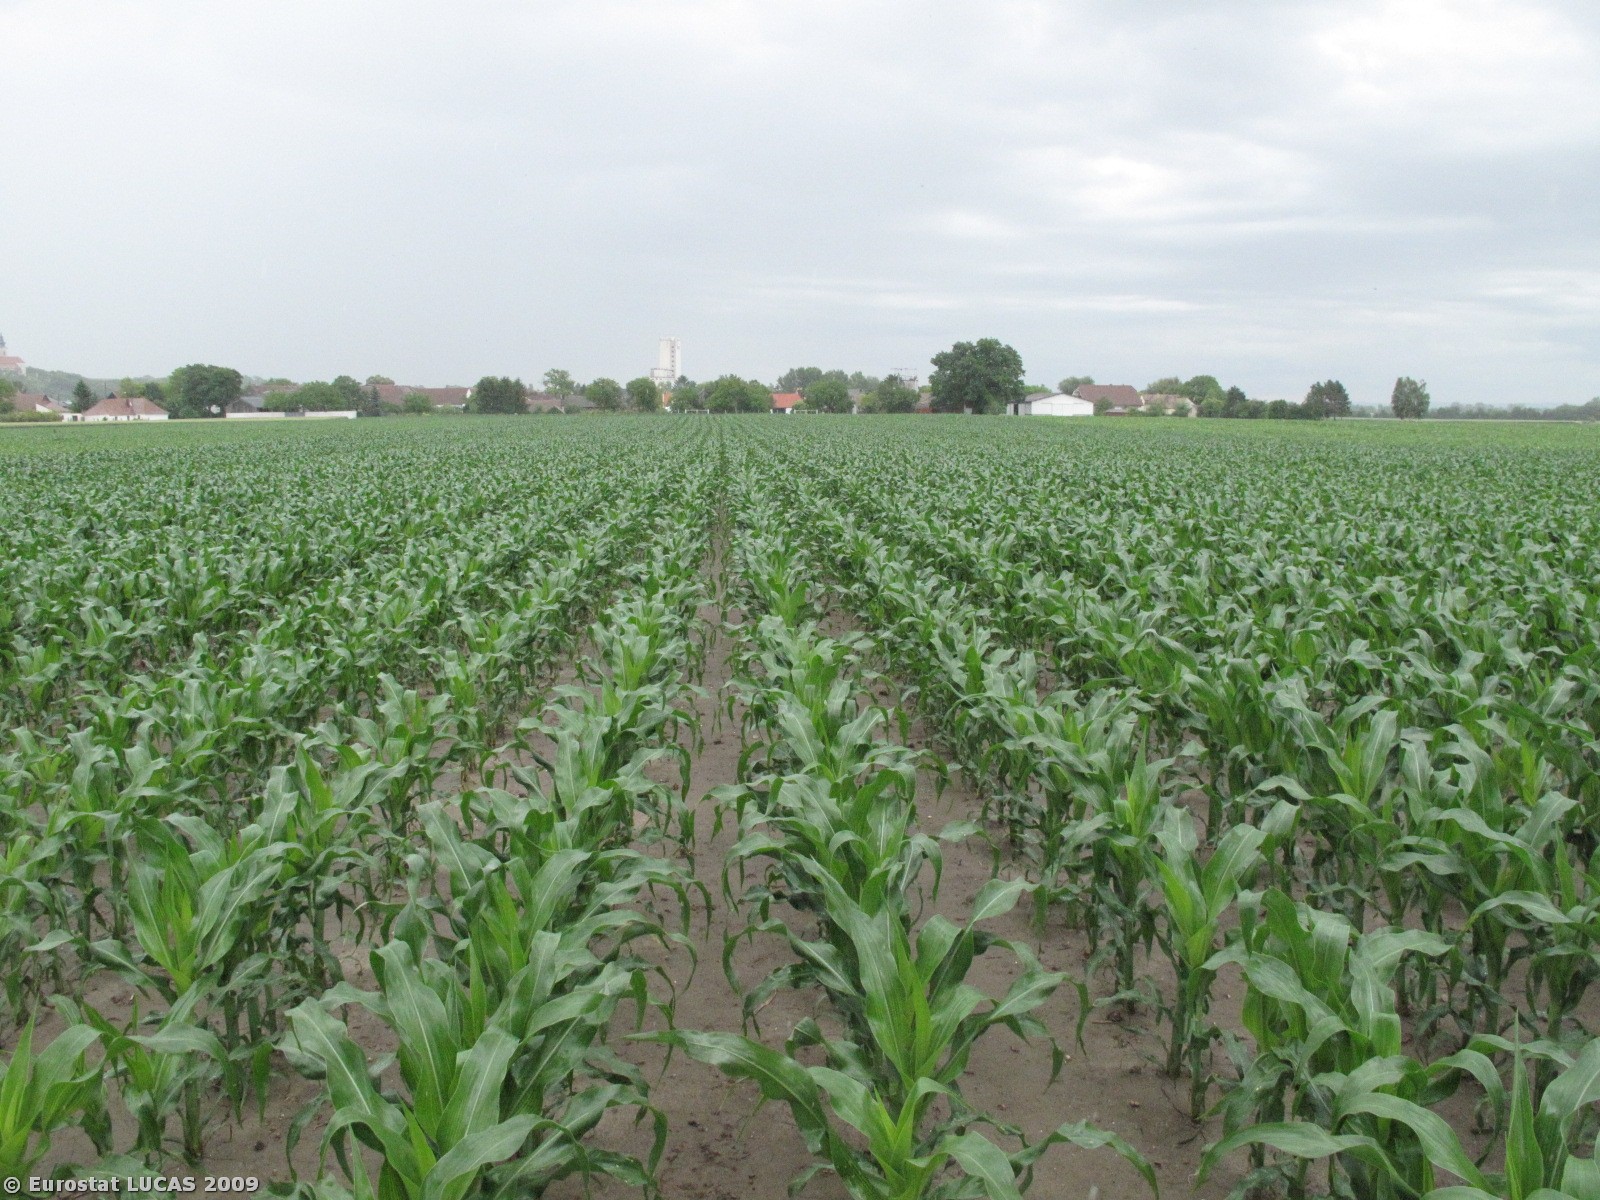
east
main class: Cropland
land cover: Maize
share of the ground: 25 - 50 %
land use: Agriculture (excluding fallow land and kitchen gardens)
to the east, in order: Maize; Electric lines; Maize
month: June
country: AT
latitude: 48.4273
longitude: 15.8825
